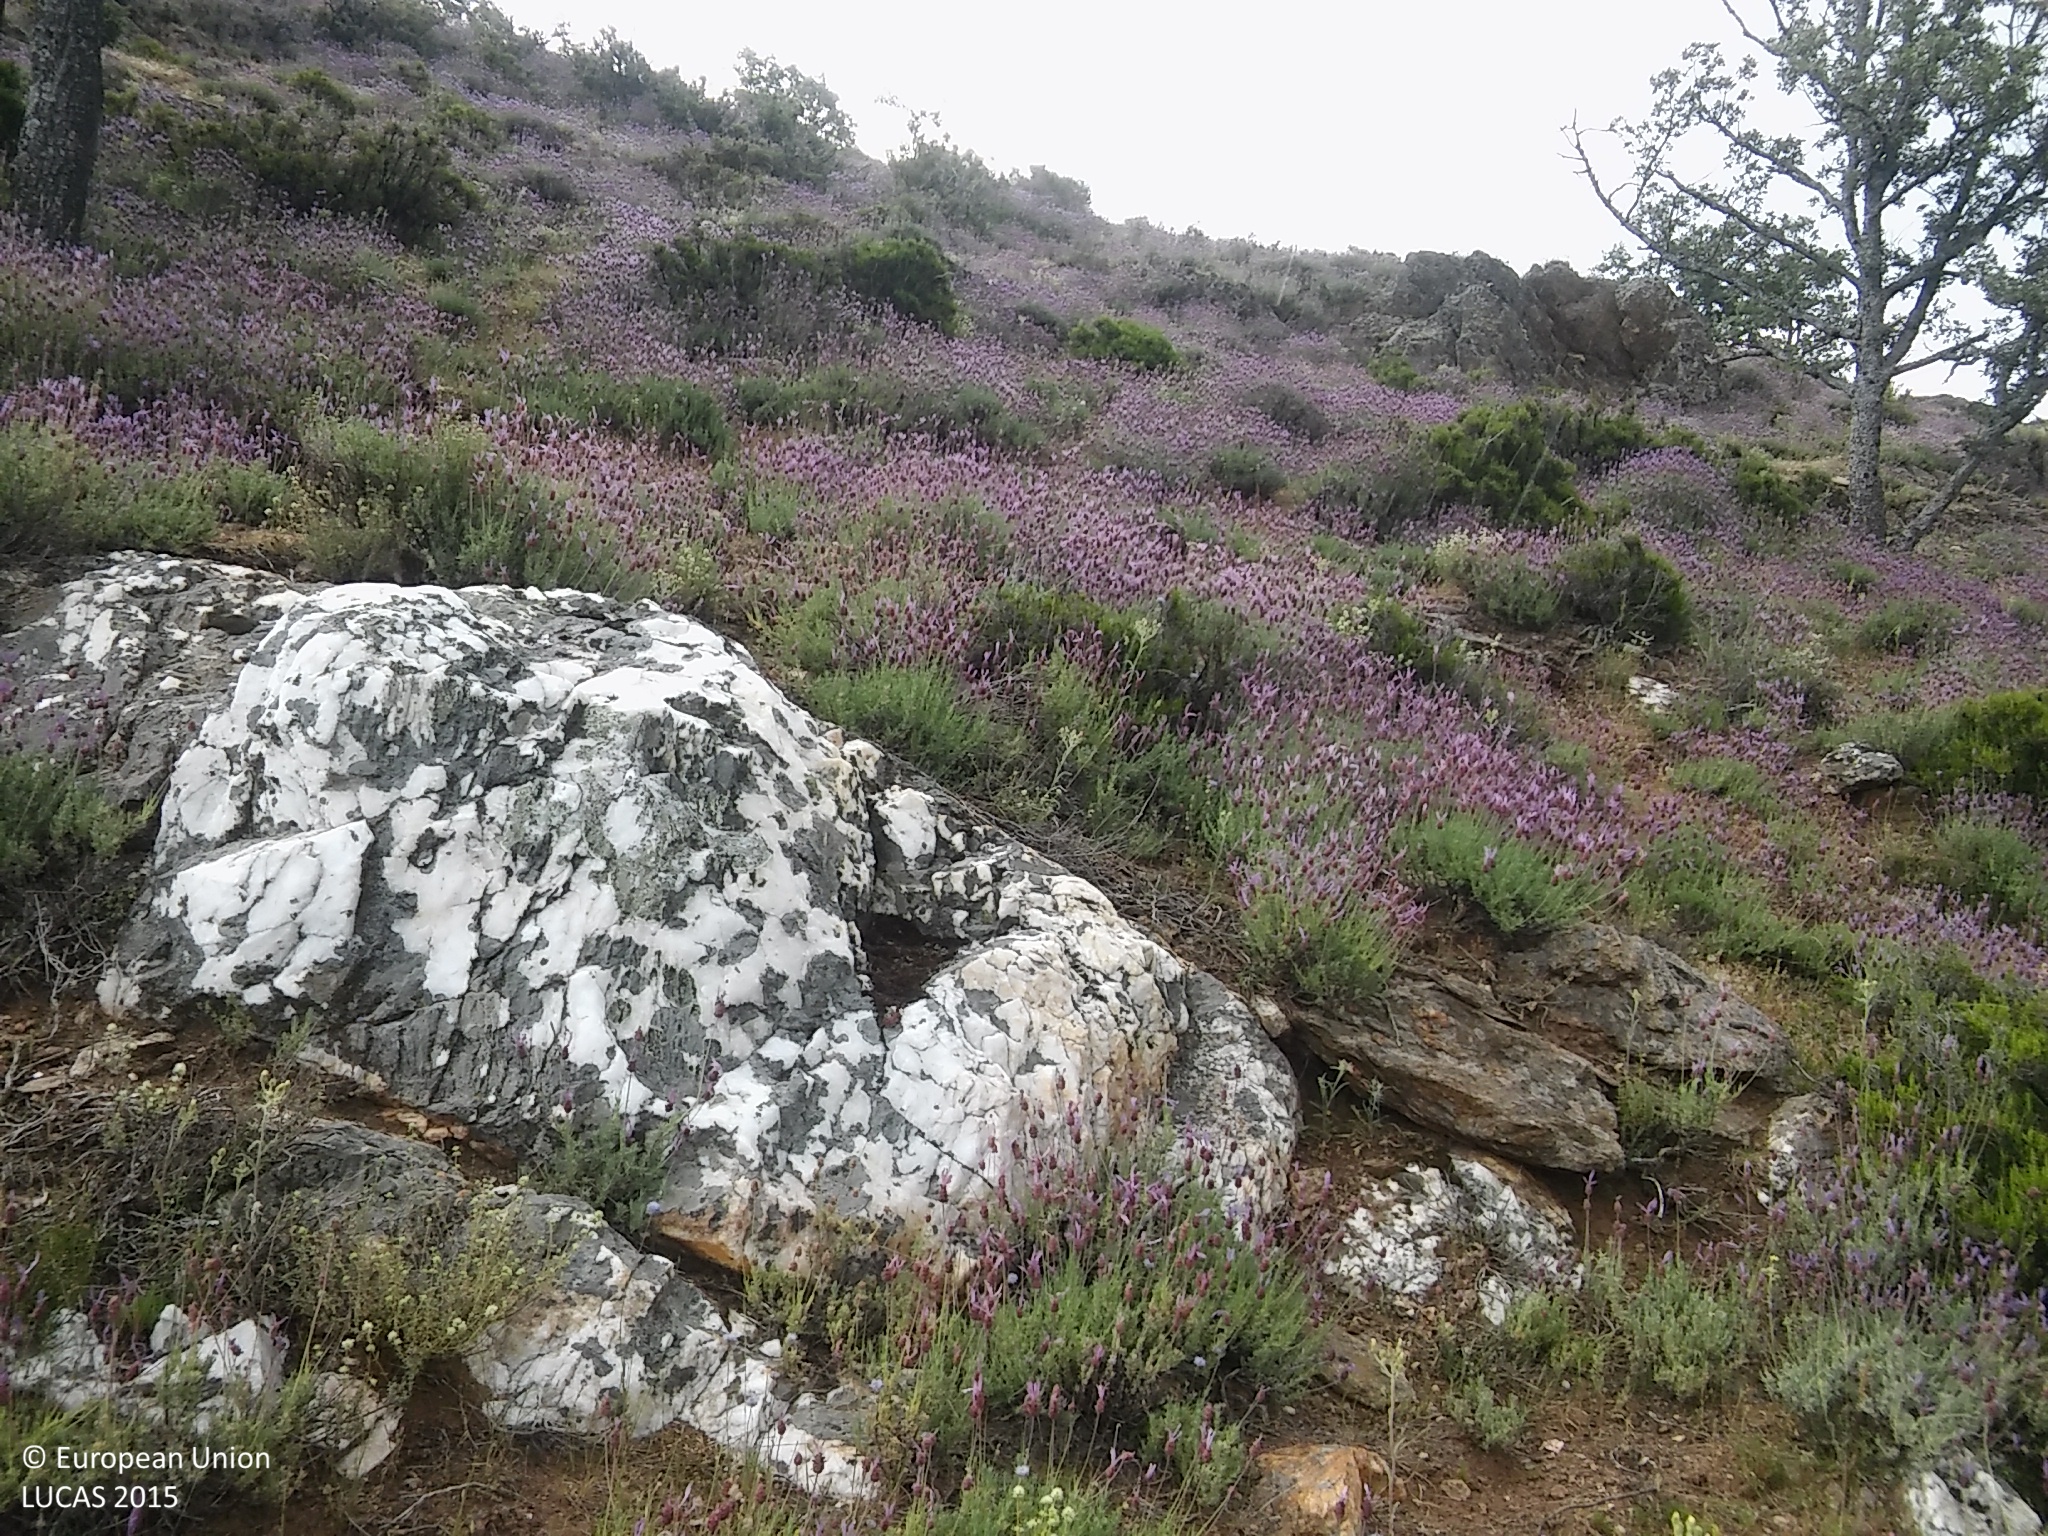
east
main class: Woodland
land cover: Broadleaved woodland
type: thermophilous deciduous forest
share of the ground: 10 - 25 %
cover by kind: shrubs 60 %, broadleaved forest trees 20 %, unconsolidated bare surface 10 %, herbaceous plants 5 %, consolidated bare surface 5 %
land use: Forestry
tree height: > 5 m
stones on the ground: 10 - 25 %
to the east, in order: Broadleaved woodland; Shrubland with sparse tree cover; Broadleaved woodland; Shrubland with sparse tree cover; Broadleaved woodland
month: June
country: ES
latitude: 41.1071
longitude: -3.4872
